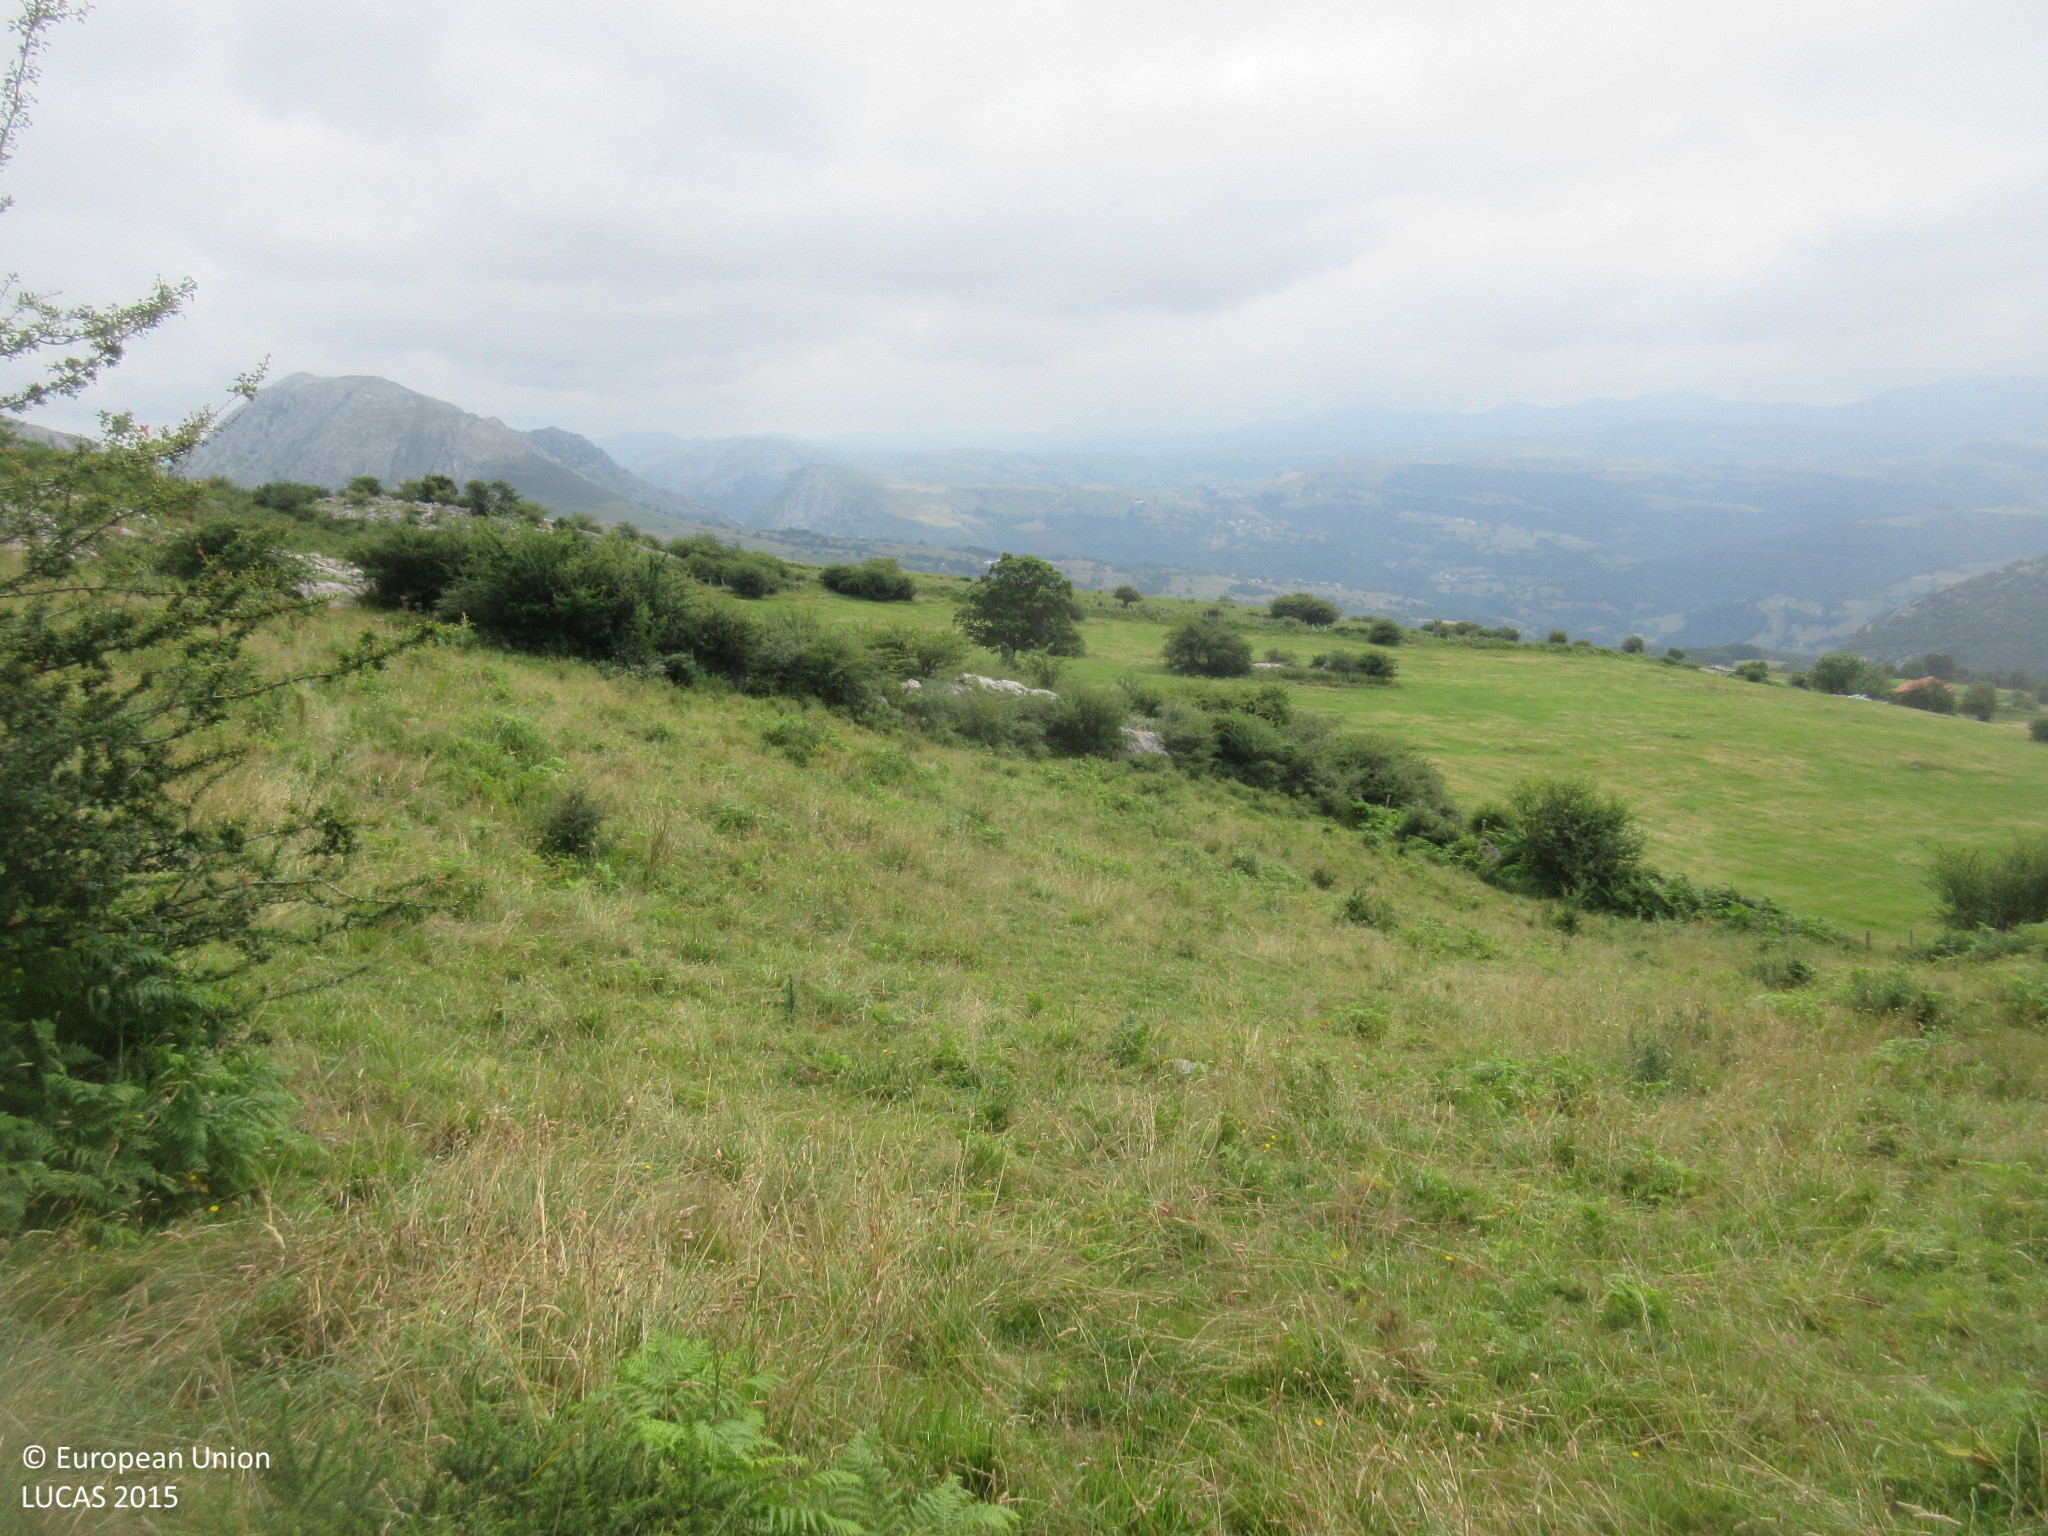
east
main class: Shrubland
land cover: Shrubland without tree cover
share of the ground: > 75 %
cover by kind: shrubs 100 %
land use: Semi-natural and natural areas not in use
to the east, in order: Shrubland without tree cover; Broadleaved woodland; Shrubland with sparse tree cover; Rocks and stones; Broadleaved woodland
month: July
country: ES
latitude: 43.2199
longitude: -3.5476
